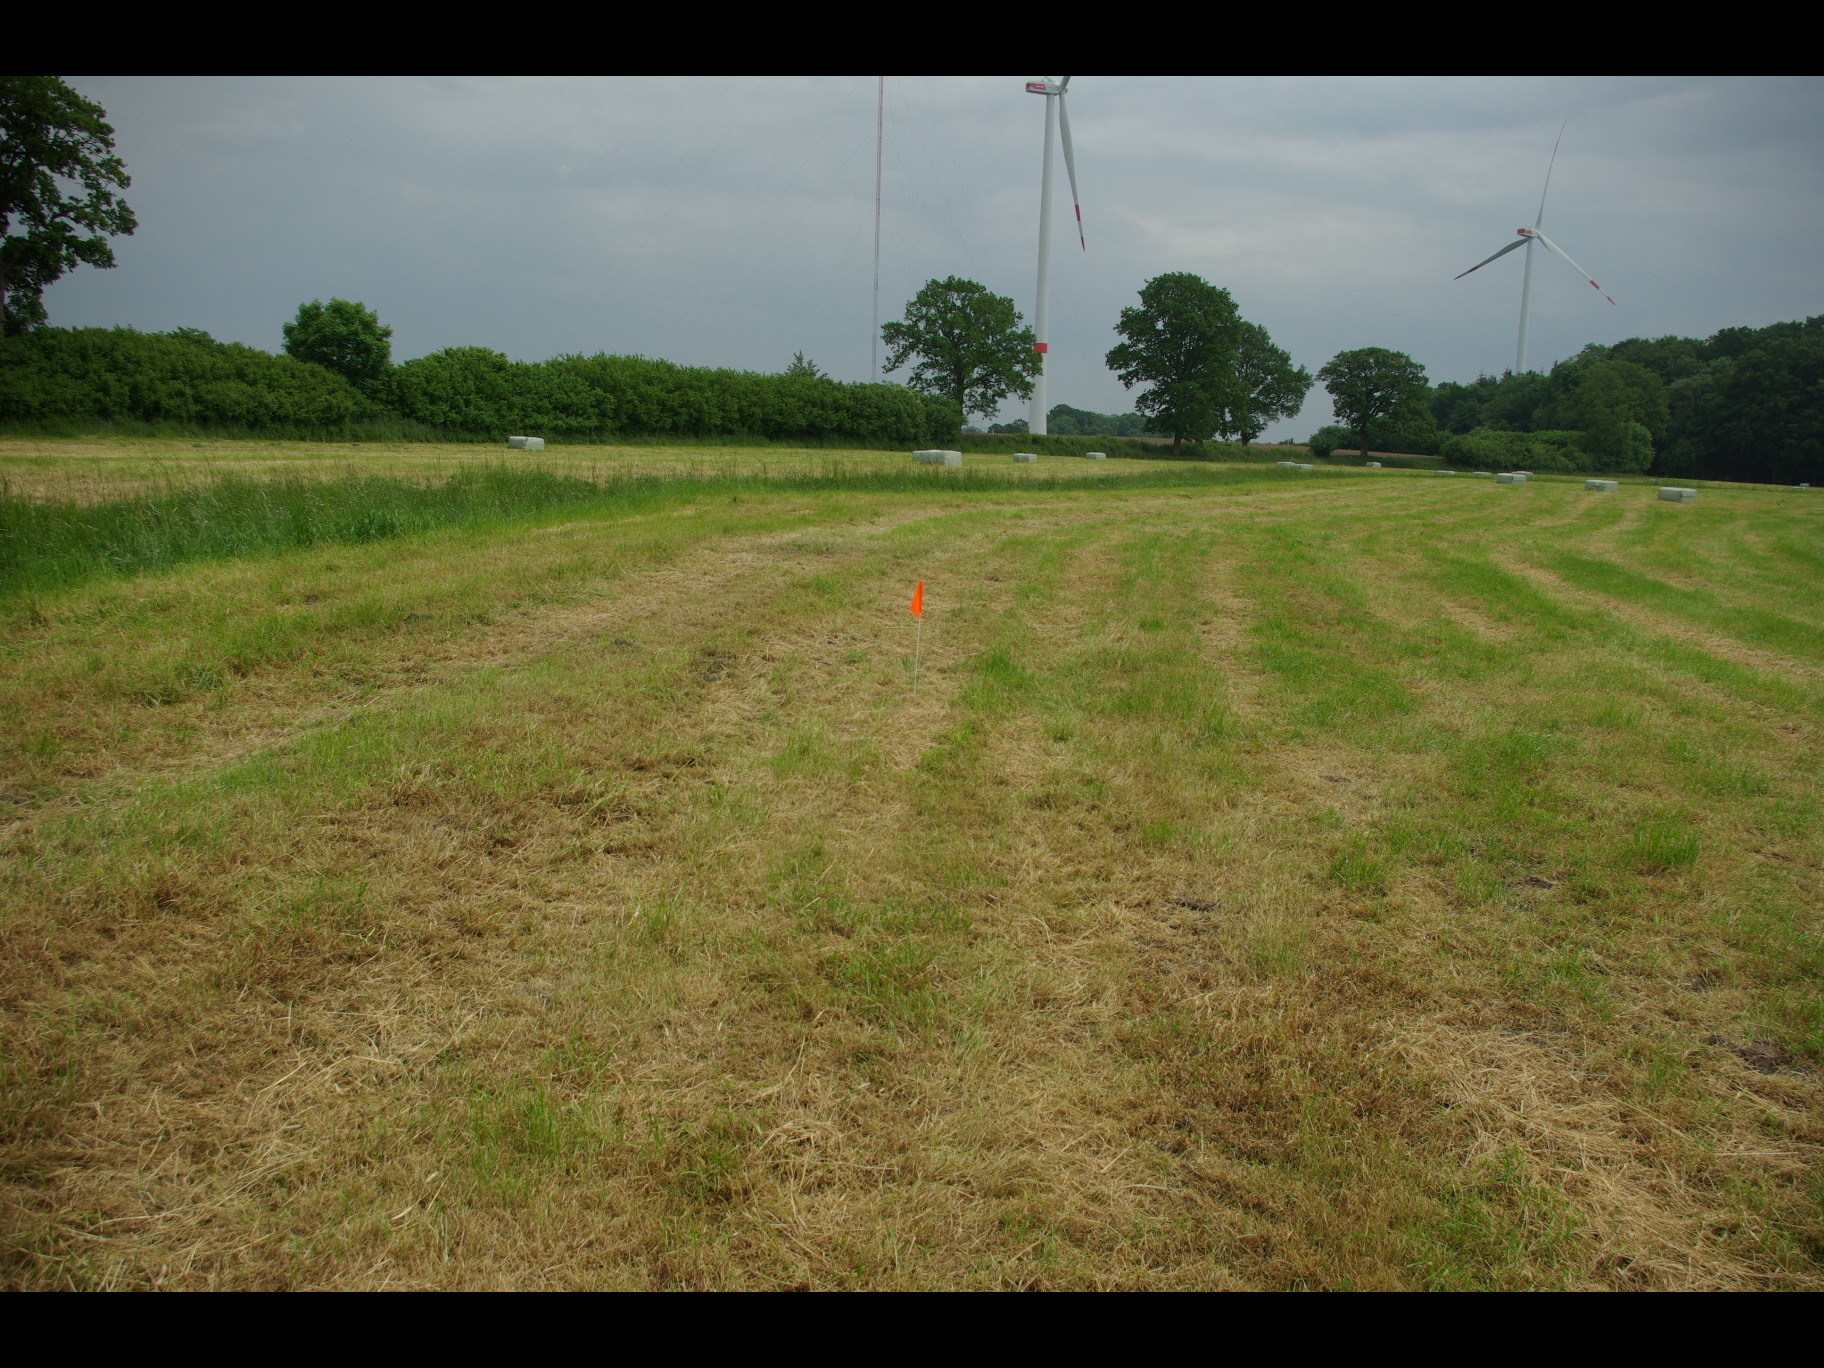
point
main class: Grassland
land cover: Grassland without tree/shrub cover
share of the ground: > 75 %
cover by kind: herbaceous plants 100 %
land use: Agriculture (excluding fallow land and kitchen gardens)
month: June
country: DE
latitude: 54.4083
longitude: 9.8922
